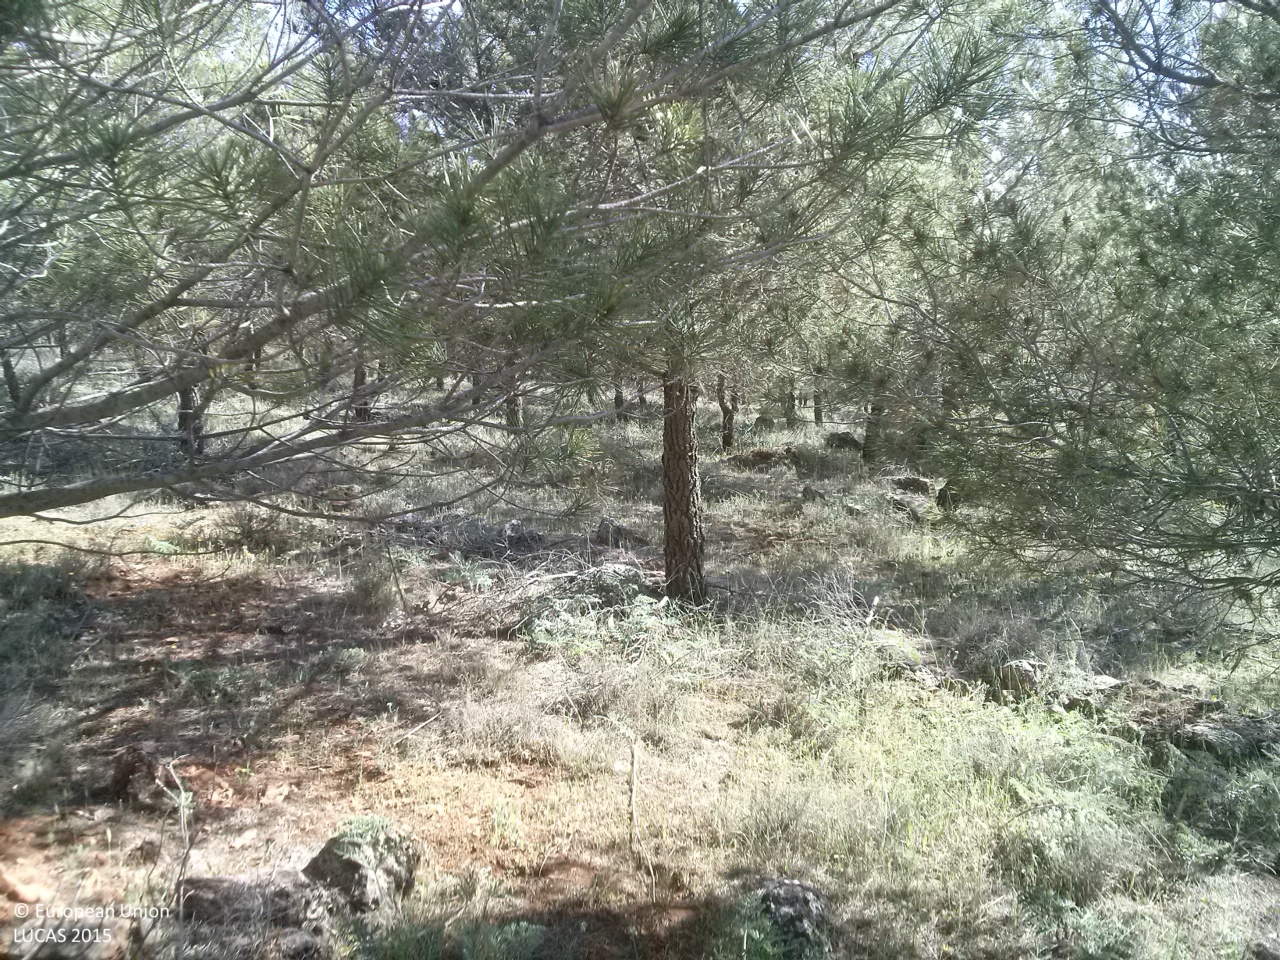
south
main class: Woodland
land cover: Pine dominated coniferous woodland
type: coniferous forest of the mediterranean region
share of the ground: 50 - 75 %
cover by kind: coniferous forest trees 65 %, herbaceous plants 25 %, consolidated bare surface 10 %
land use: Forestry
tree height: < 5 m
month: May
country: ES
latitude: 39.8320
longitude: -2.7670
